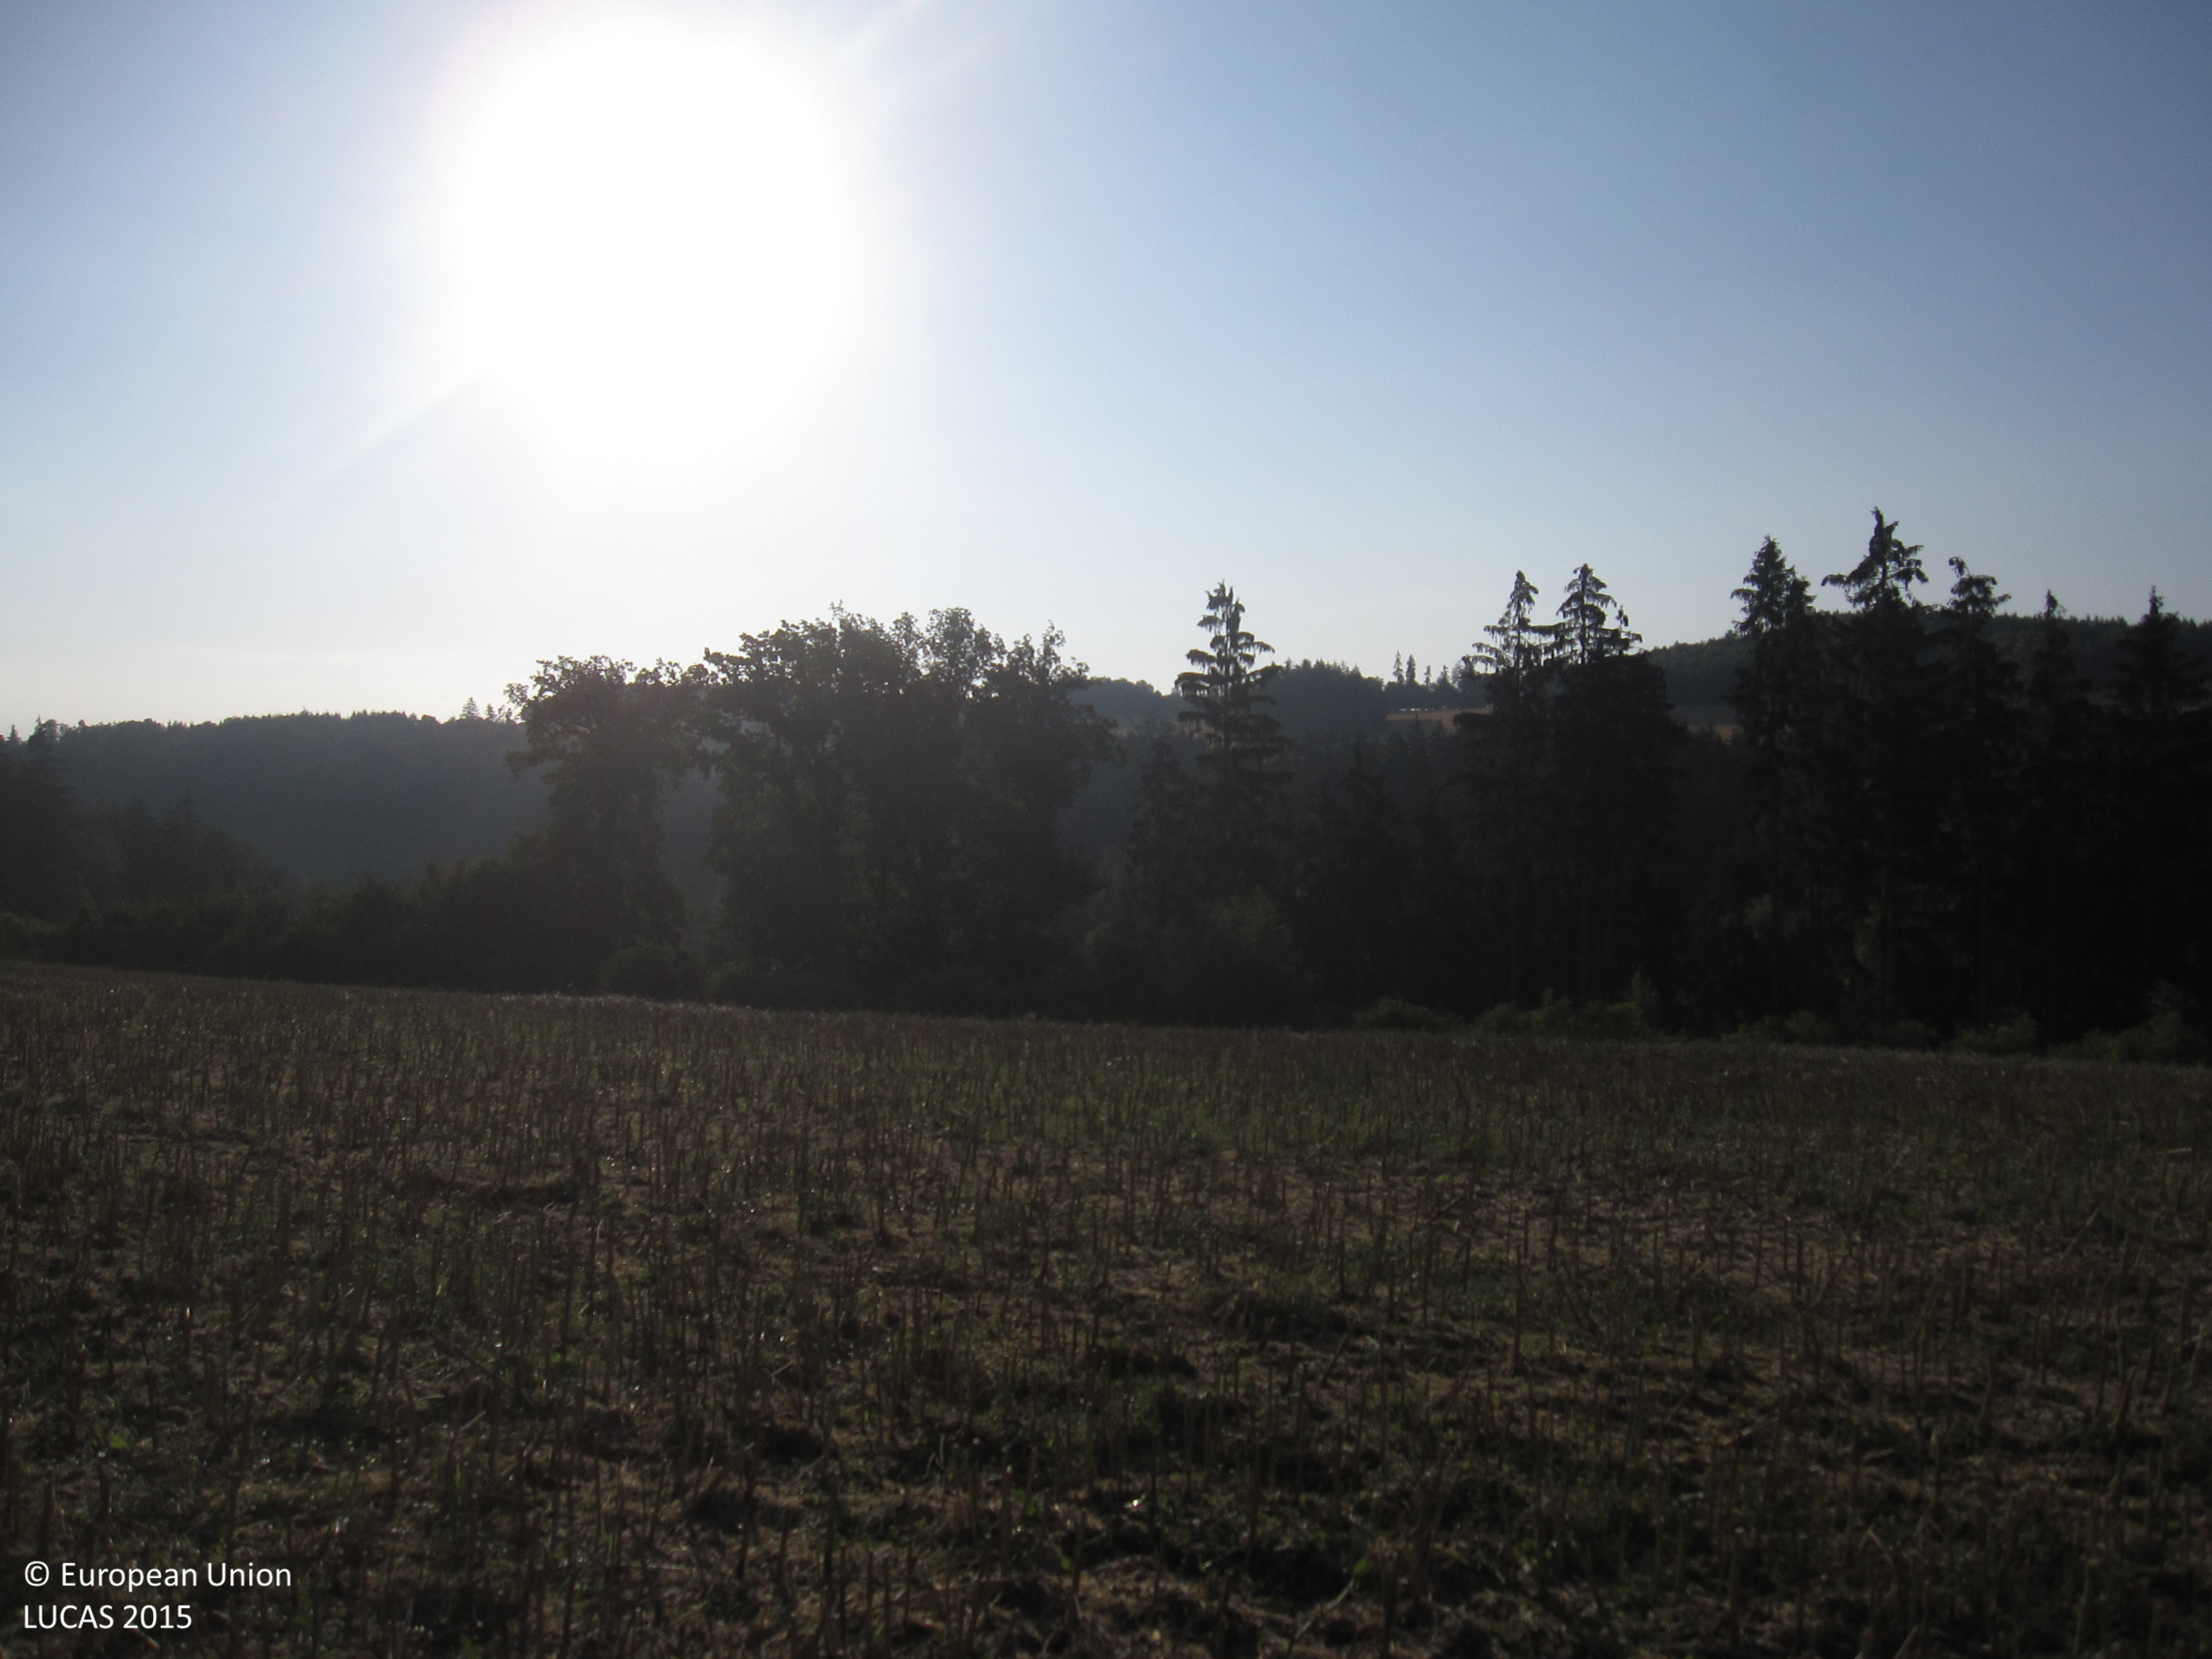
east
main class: Cropland
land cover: Rape and turnip rape
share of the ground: < 10 %
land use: Agriculture (excluding fallow land and kitchen gardens)
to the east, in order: Rape and turnip rape; Shrubland with sparse tree cover; Pine dominated coniferous woodland; Fences; Pine dominated coniferous woodland; Fences; Pine dominated coniferous woodland; Broadleaved woodland; Tracks; Grassland without tree/shrub cover; Broadleaved woodland; Rivers and streams; Broadleaved woodland; Fences; Grassland without tree/shrub cover
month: July
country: DE
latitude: 50.4178
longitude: 12.0403
